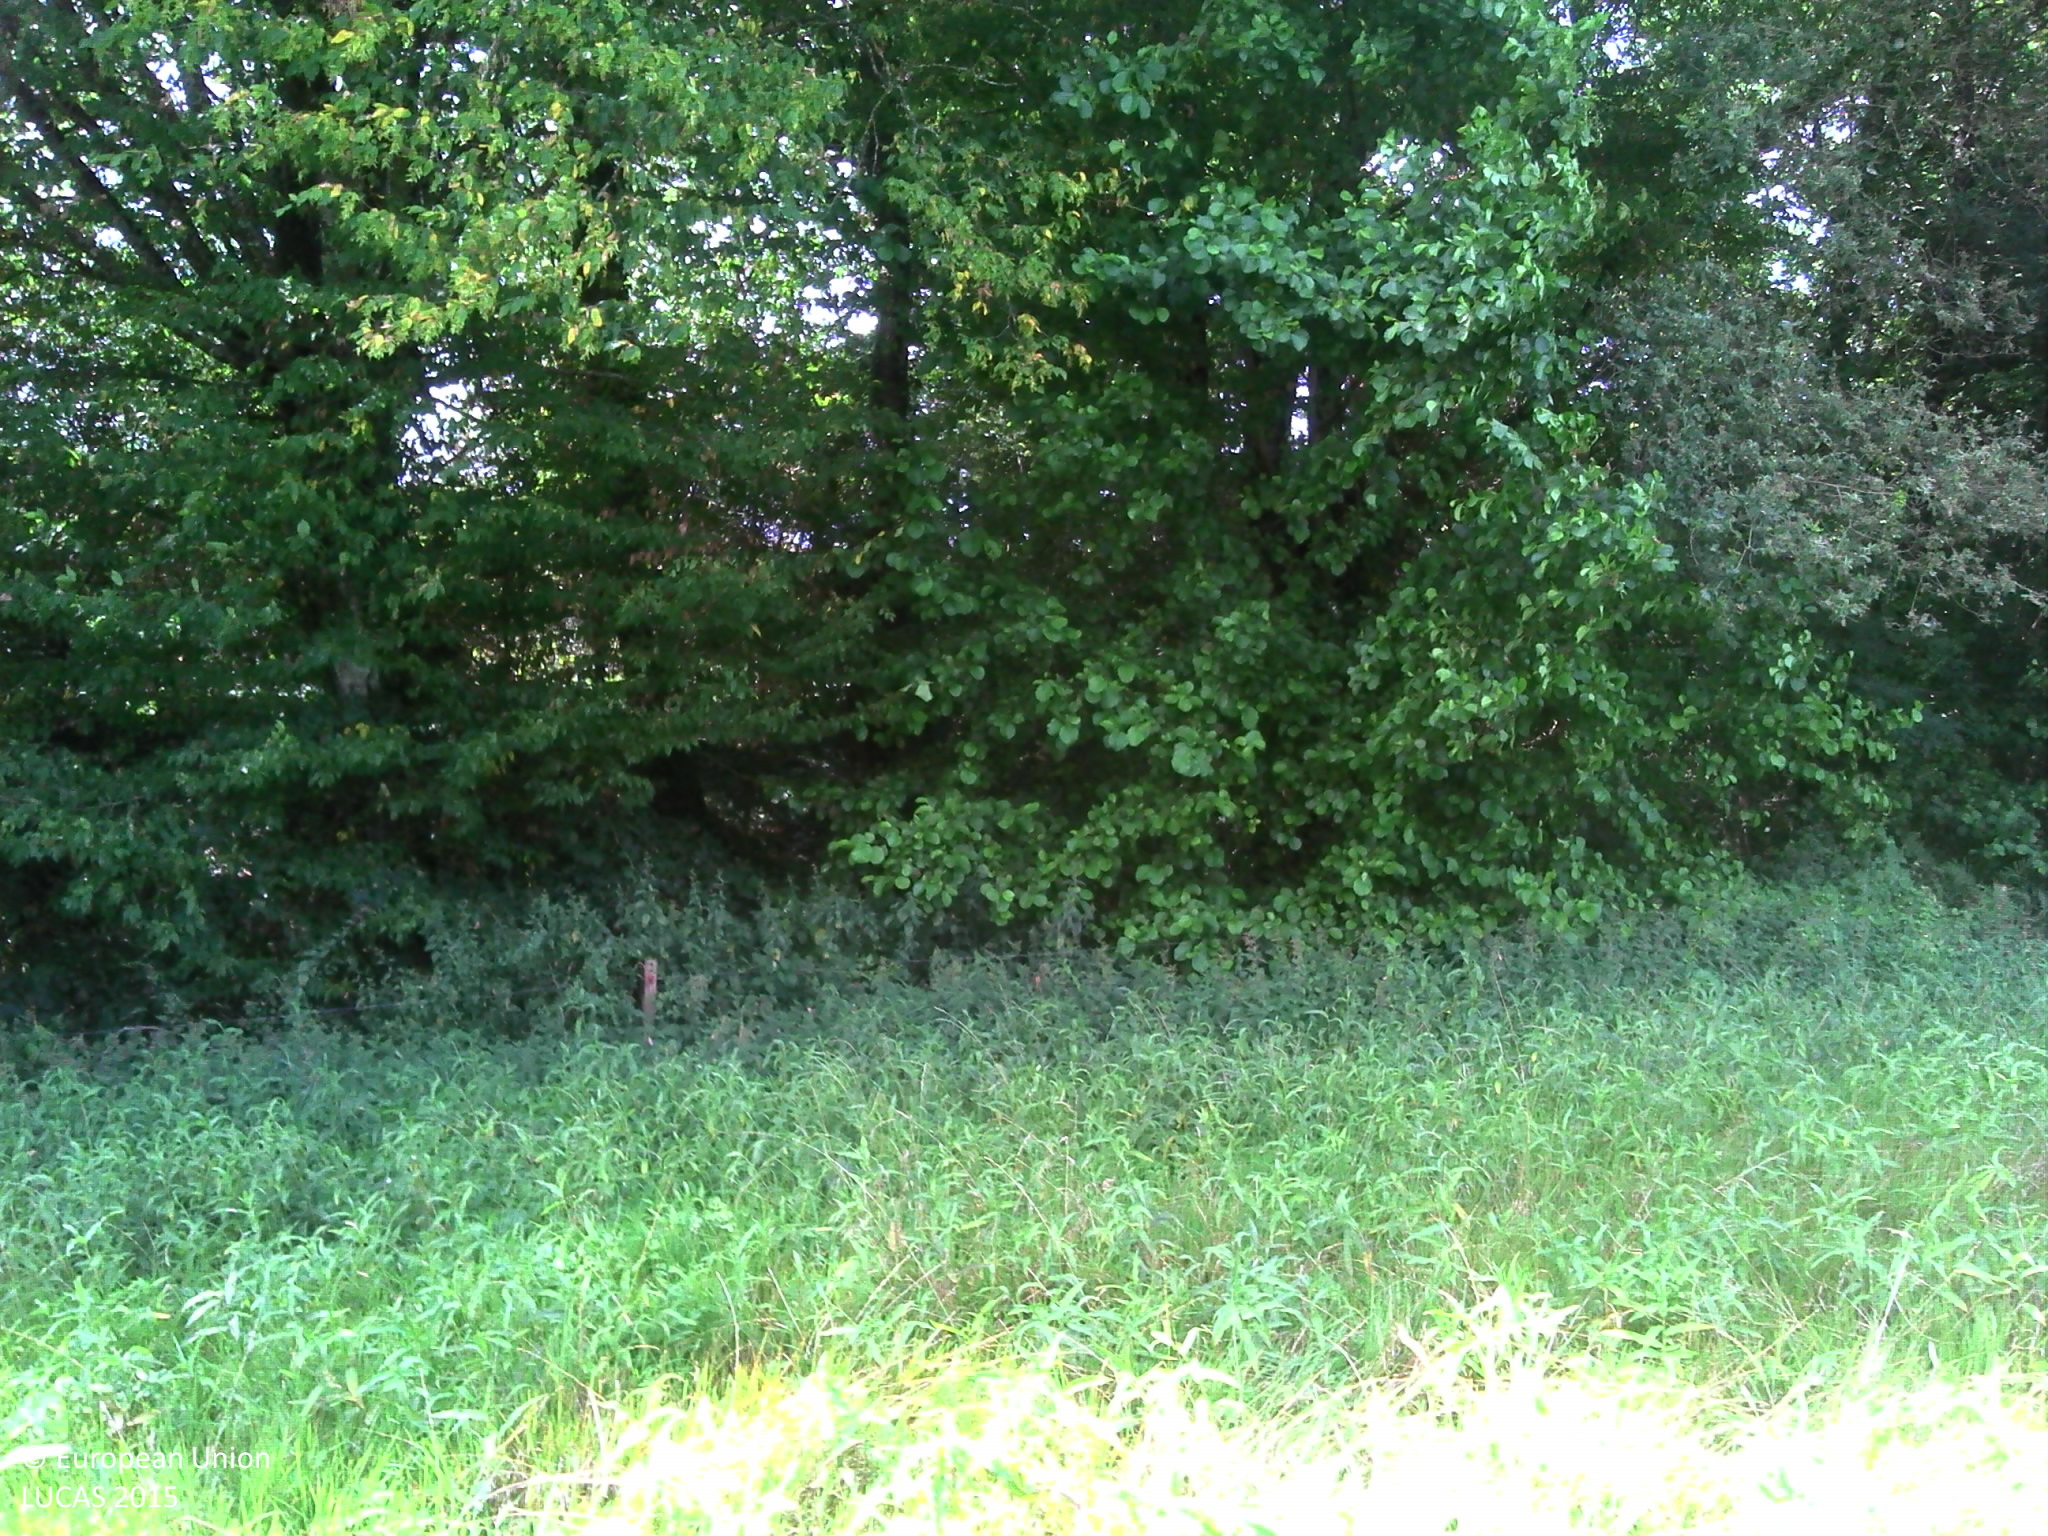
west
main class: Grassland
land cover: Grassland without tree/shrub cover
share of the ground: > 75 %
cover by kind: herbaceous plants 100 %
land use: Agriculture (excluding fallow land and kitchen gardens)
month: August
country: FR
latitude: 46.7834
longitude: -1.1556
